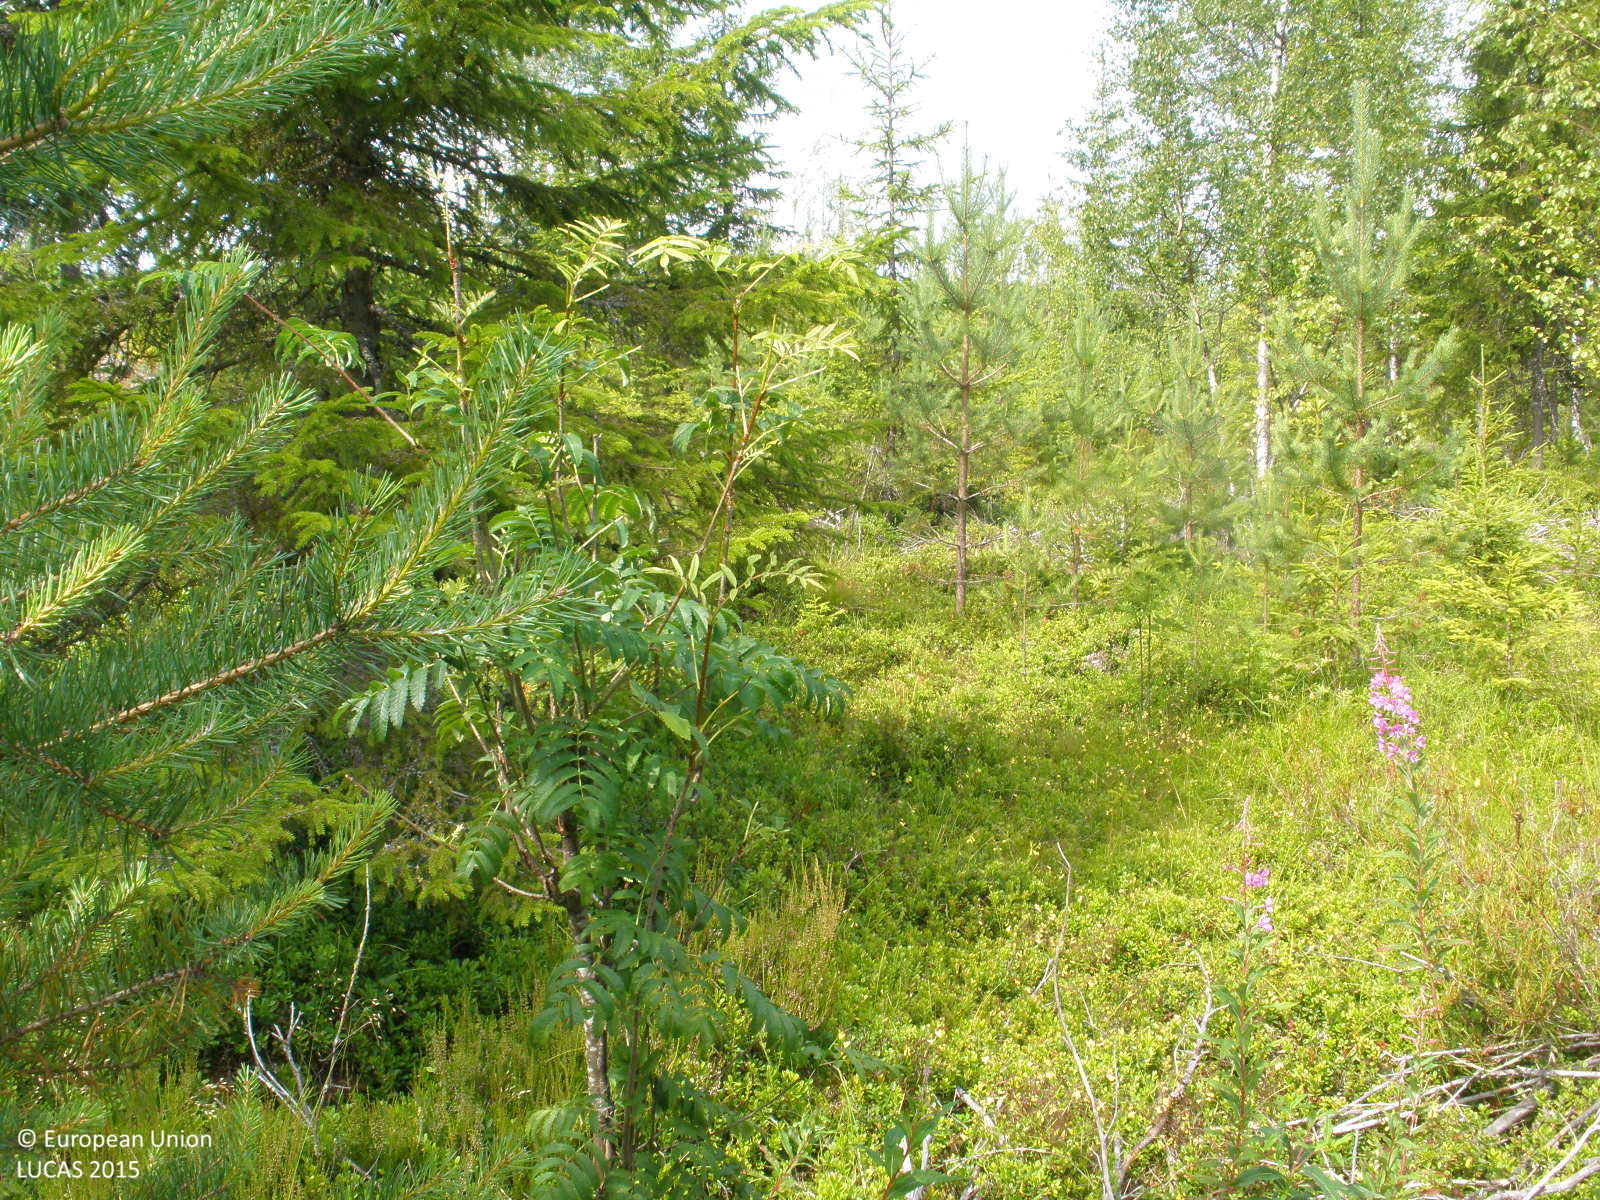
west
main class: Woodland
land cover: Pine dominated mixed woodland
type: boreal forest
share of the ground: 50 - 75 %
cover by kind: coniferous forest trees 40 %, broadleaved forest trees 30 %, herbaceous plants 15 %, lichens and mosses 10 %, shrubs 5 %
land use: Forestry
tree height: < 5 m
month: July
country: FI
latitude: 61.4877
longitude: 24.8095
